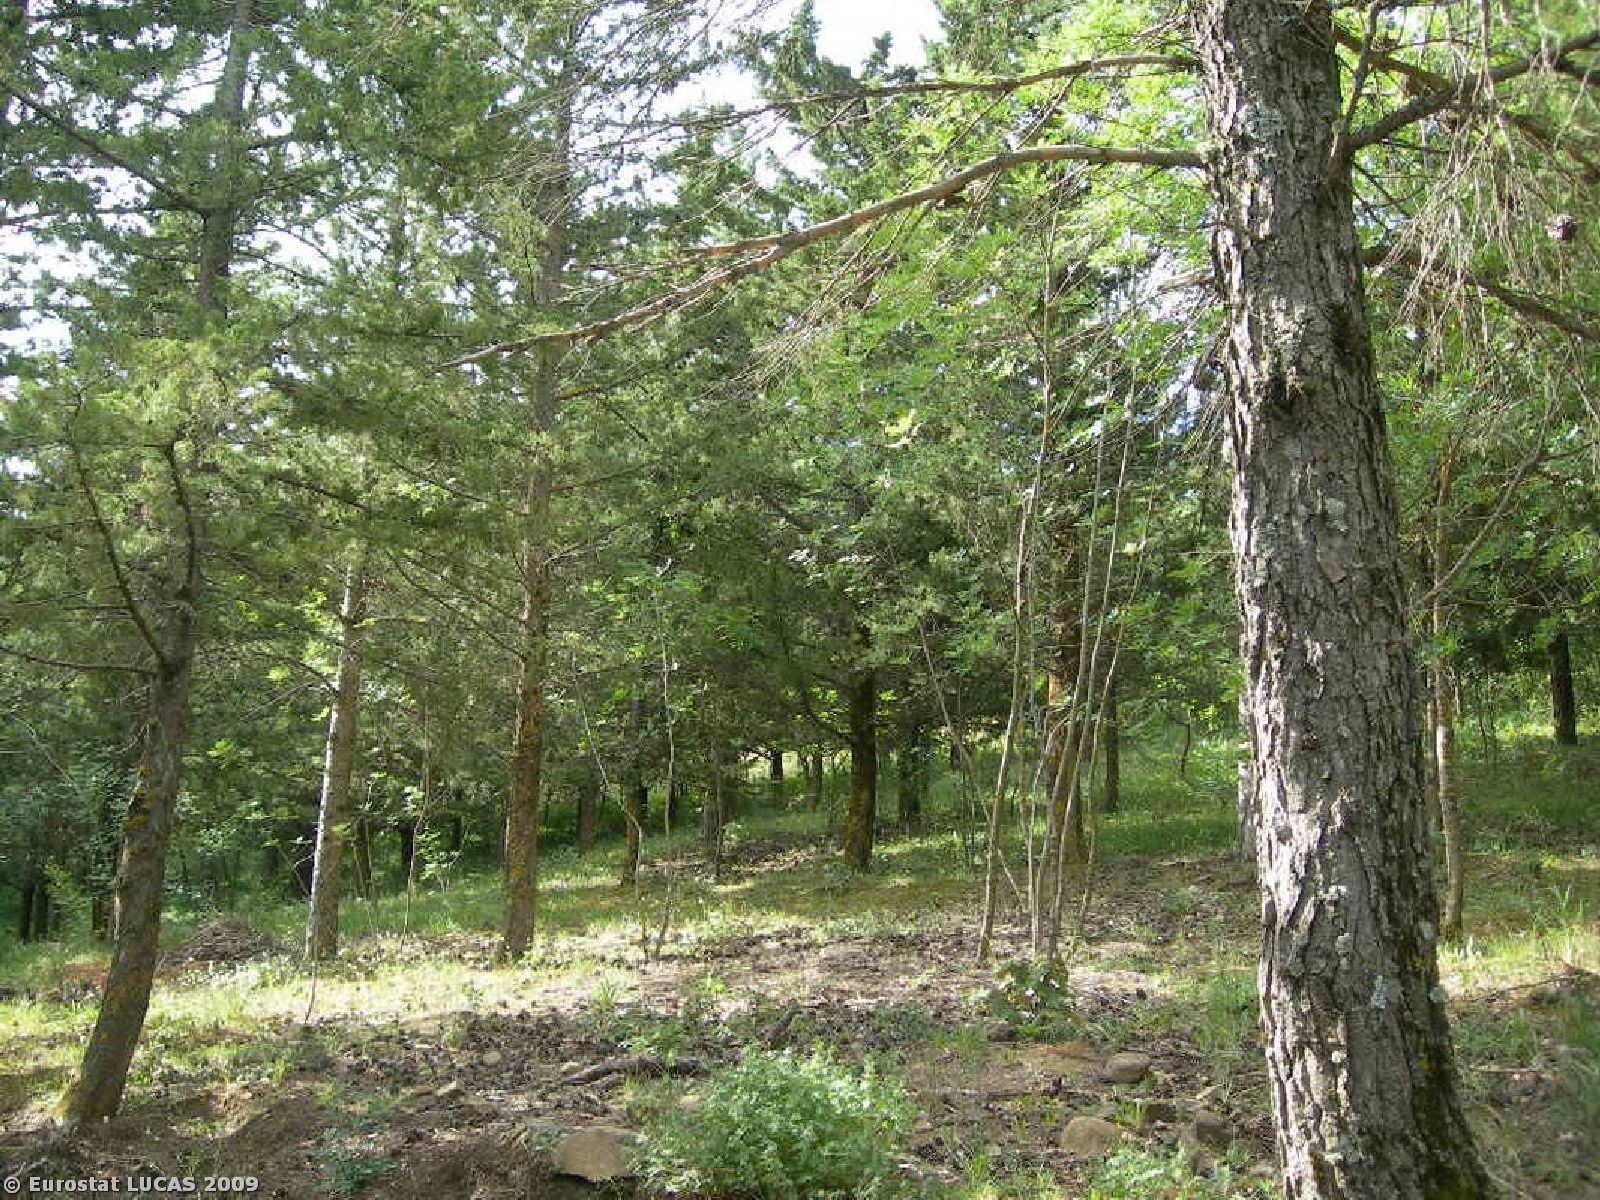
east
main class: Woodland
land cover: Mixed woodland
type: thermophilous deciduous forest
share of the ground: > 75 %
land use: Nature reserves
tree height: > 5 m
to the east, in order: Mixed woodland; Grassland with sparse tree/shrub cover
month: June
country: IT
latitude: 37.8057
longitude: 14.0712
